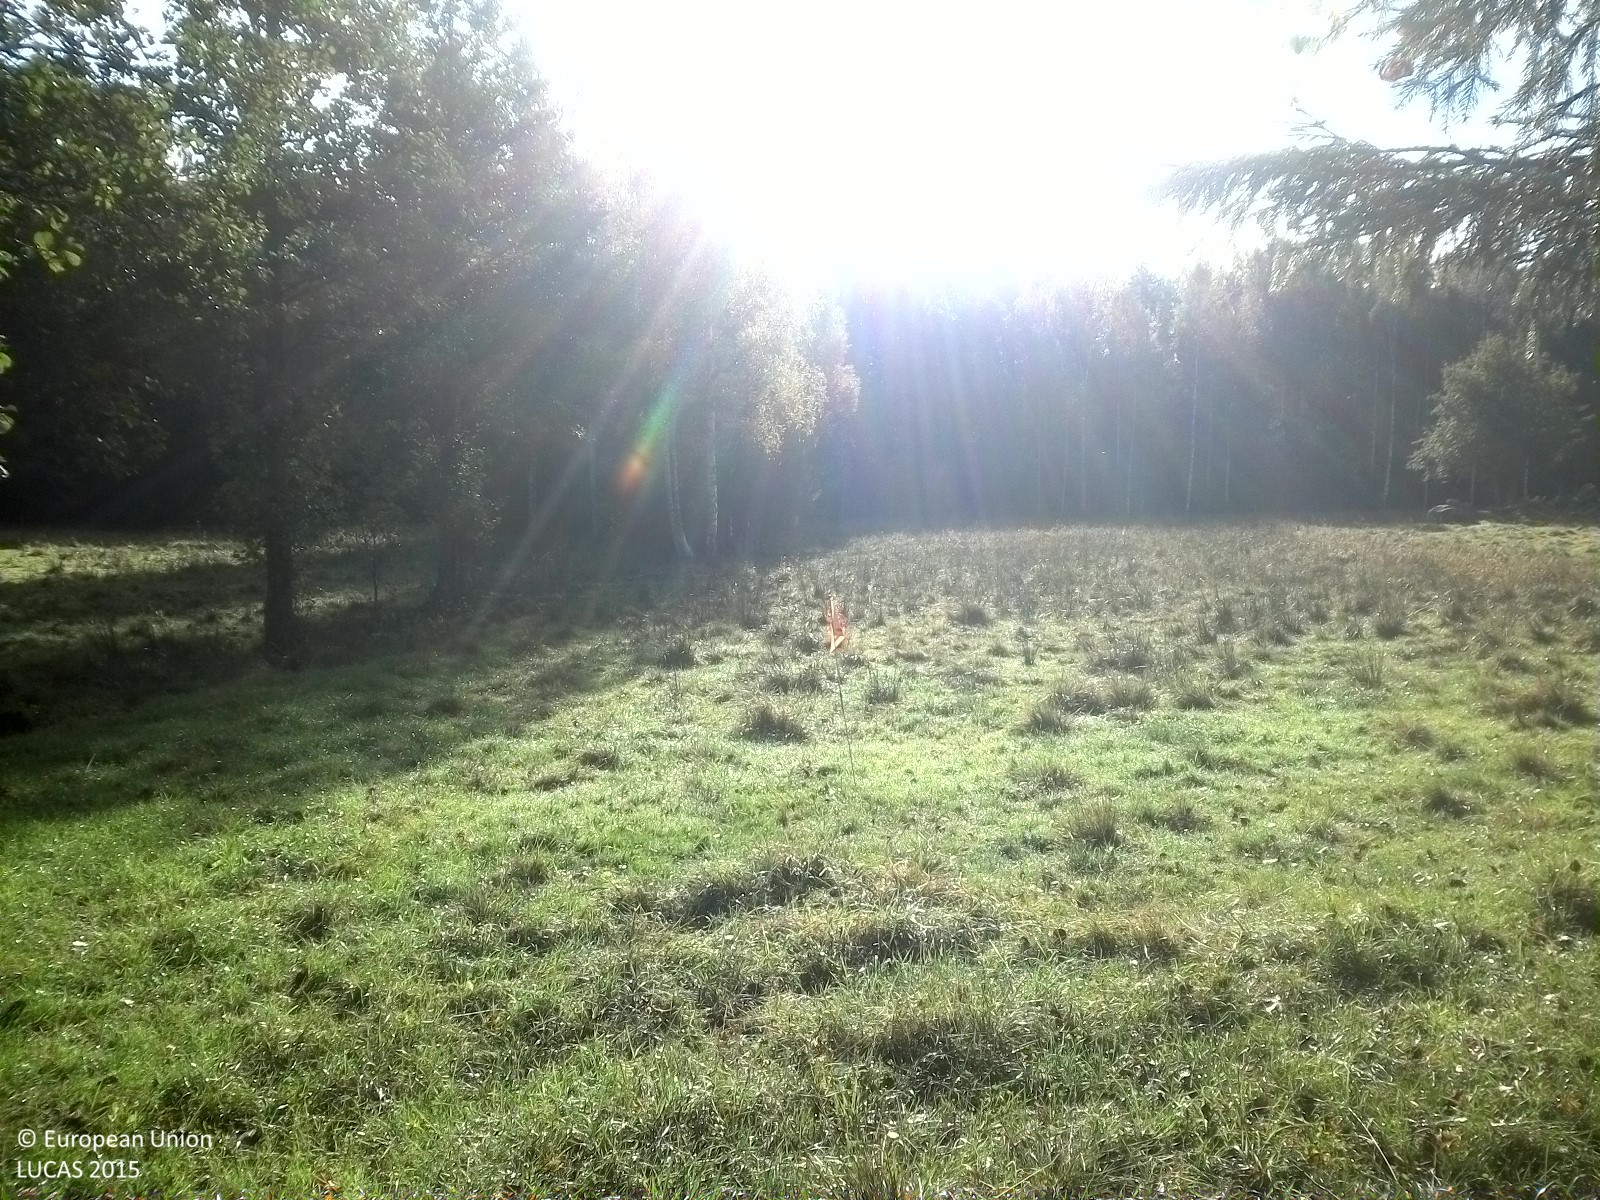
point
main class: Grassland
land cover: Grassland without tree/shrub cover
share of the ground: > 75 %
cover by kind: herbaceous plants 100 %
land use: Agriculture (excluding fallow land and kitchen gardens)
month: September
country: SE
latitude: 58.9582
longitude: 15.8524
